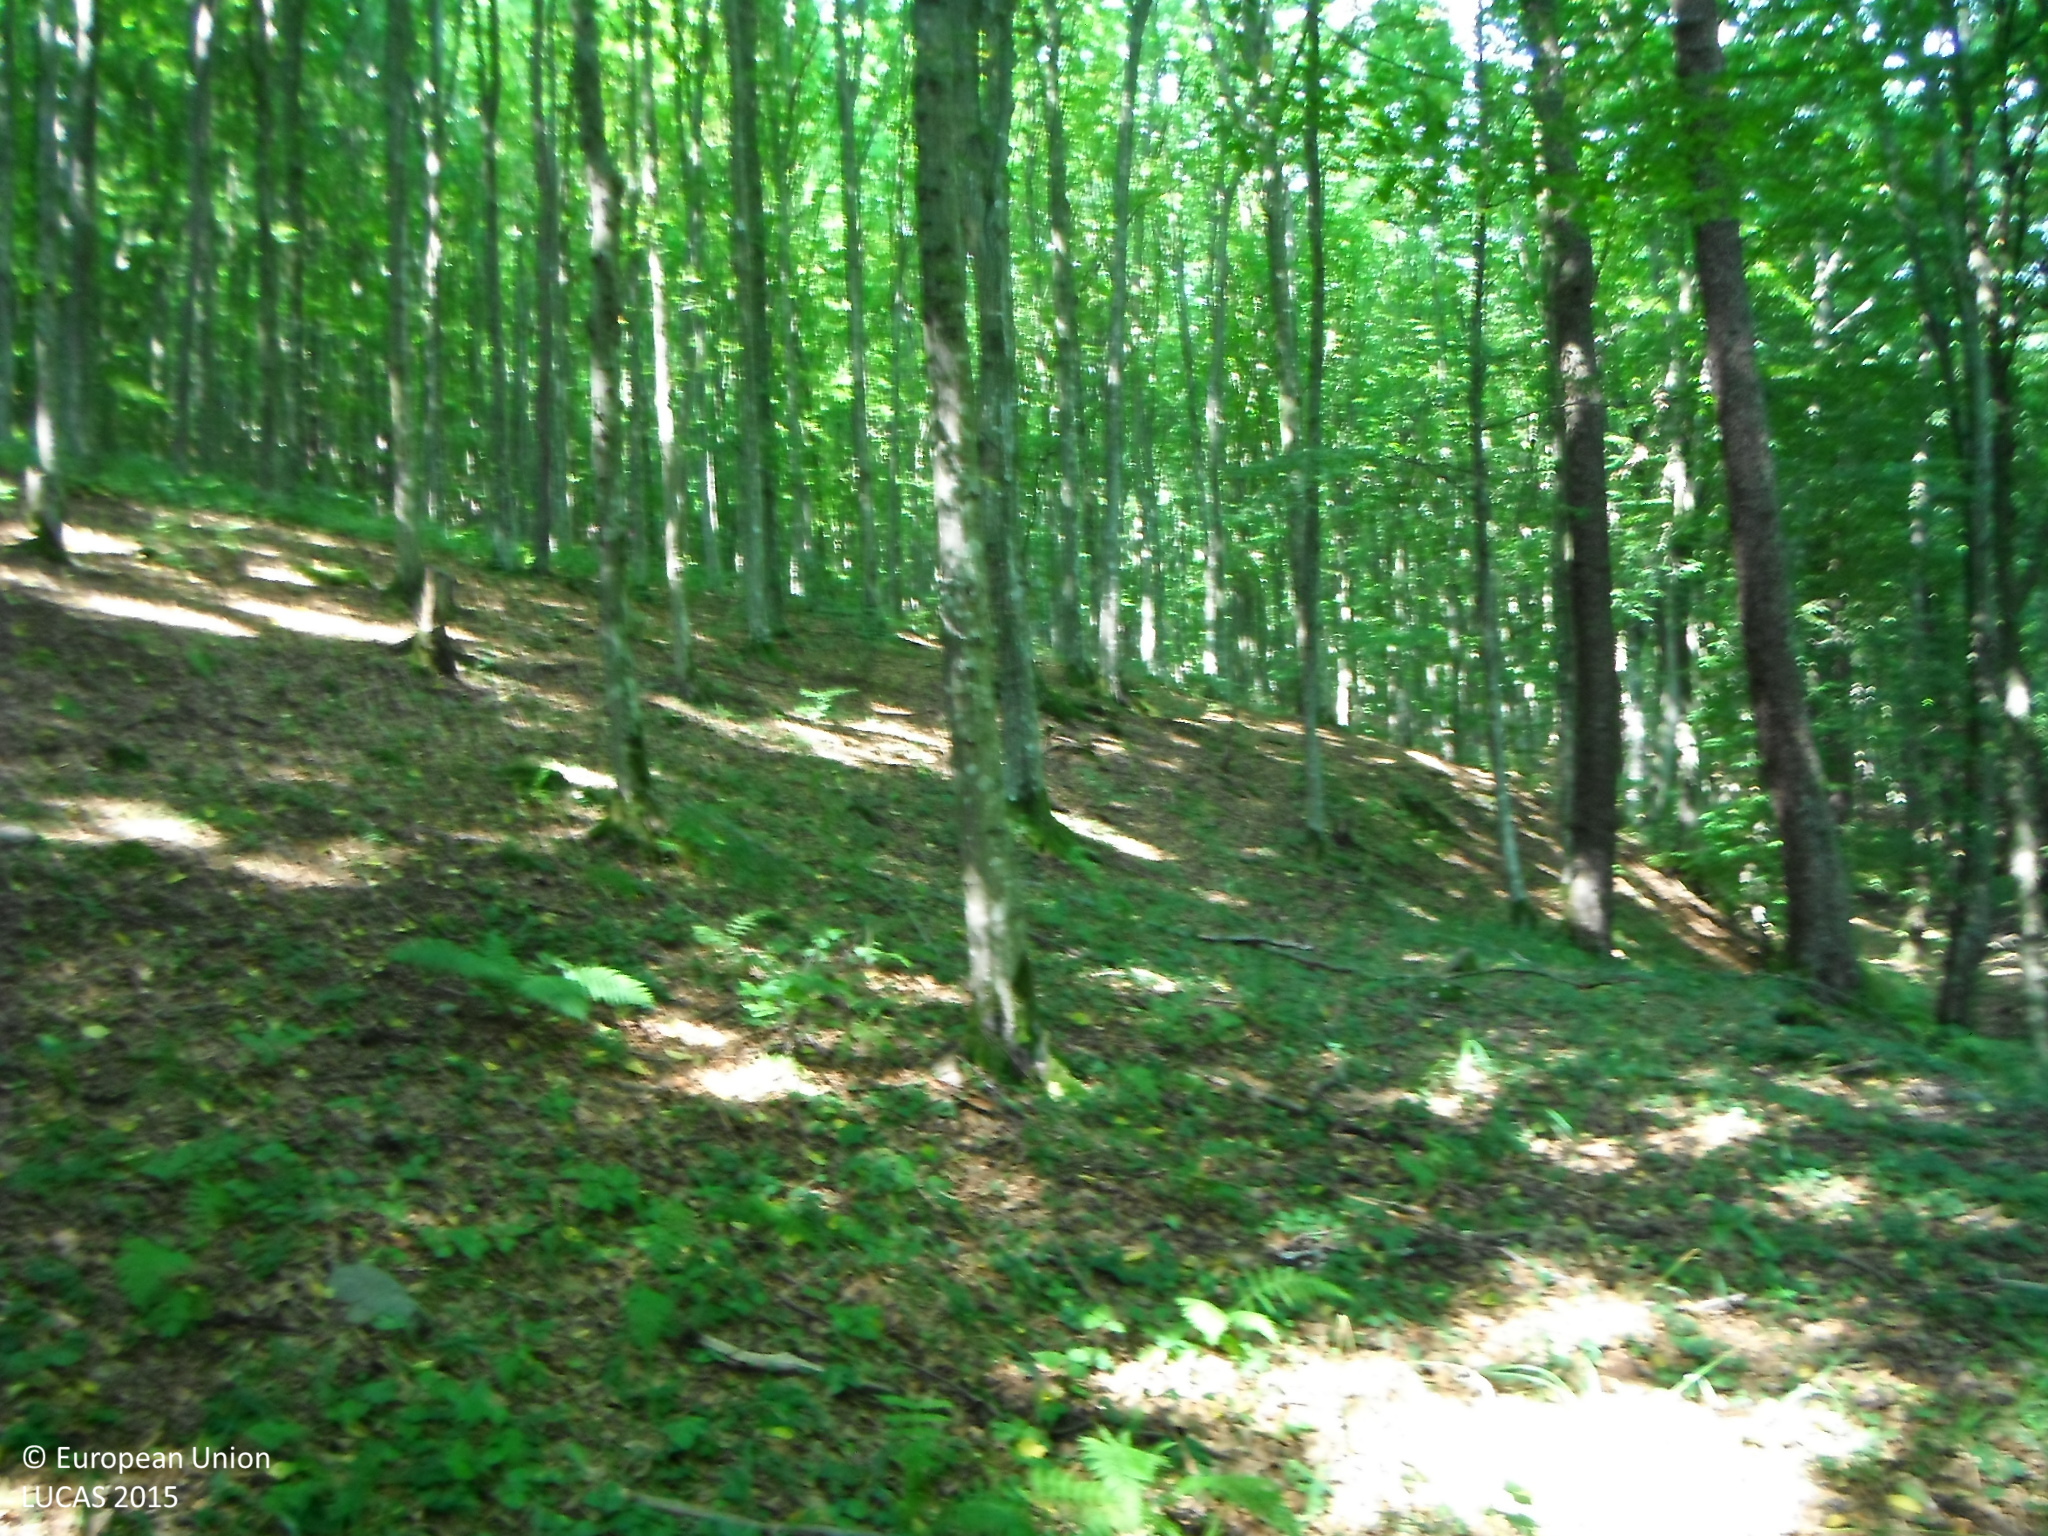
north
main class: Woodland
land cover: Broadleaved woodland
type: mesophytic deciduous forest
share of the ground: > 75 %
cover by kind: broadleaved forest trees 100 %
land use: Forestry
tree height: > 5 m
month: August
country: SK
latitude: 48.6942
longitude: 20.5650
